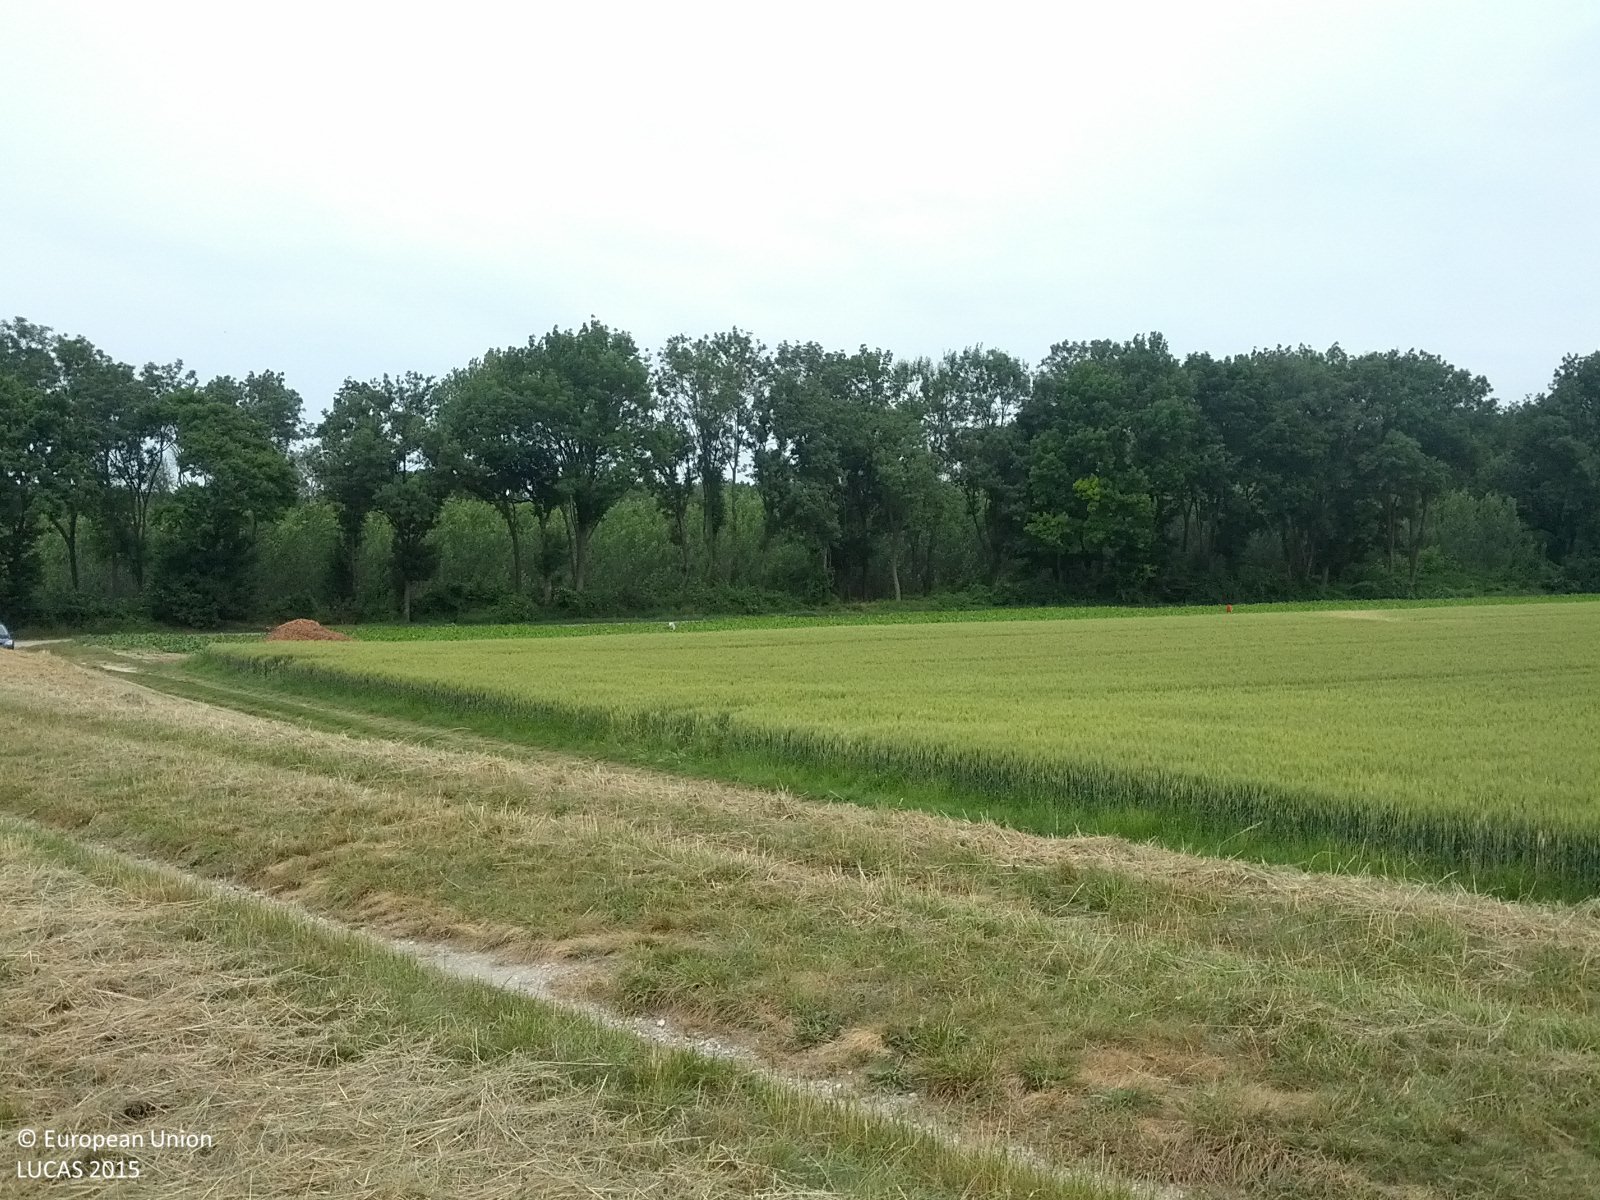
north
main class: Grassland
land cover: Grassland without tree/shrub cover
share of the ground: > 75 %
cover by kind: herbaceous plants 100 %
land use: Protection infrastructures
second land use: Agriculture (excluding fallow land and kitchen gardens)
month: June
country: AT
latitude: 48.1534
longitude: 16.5790
